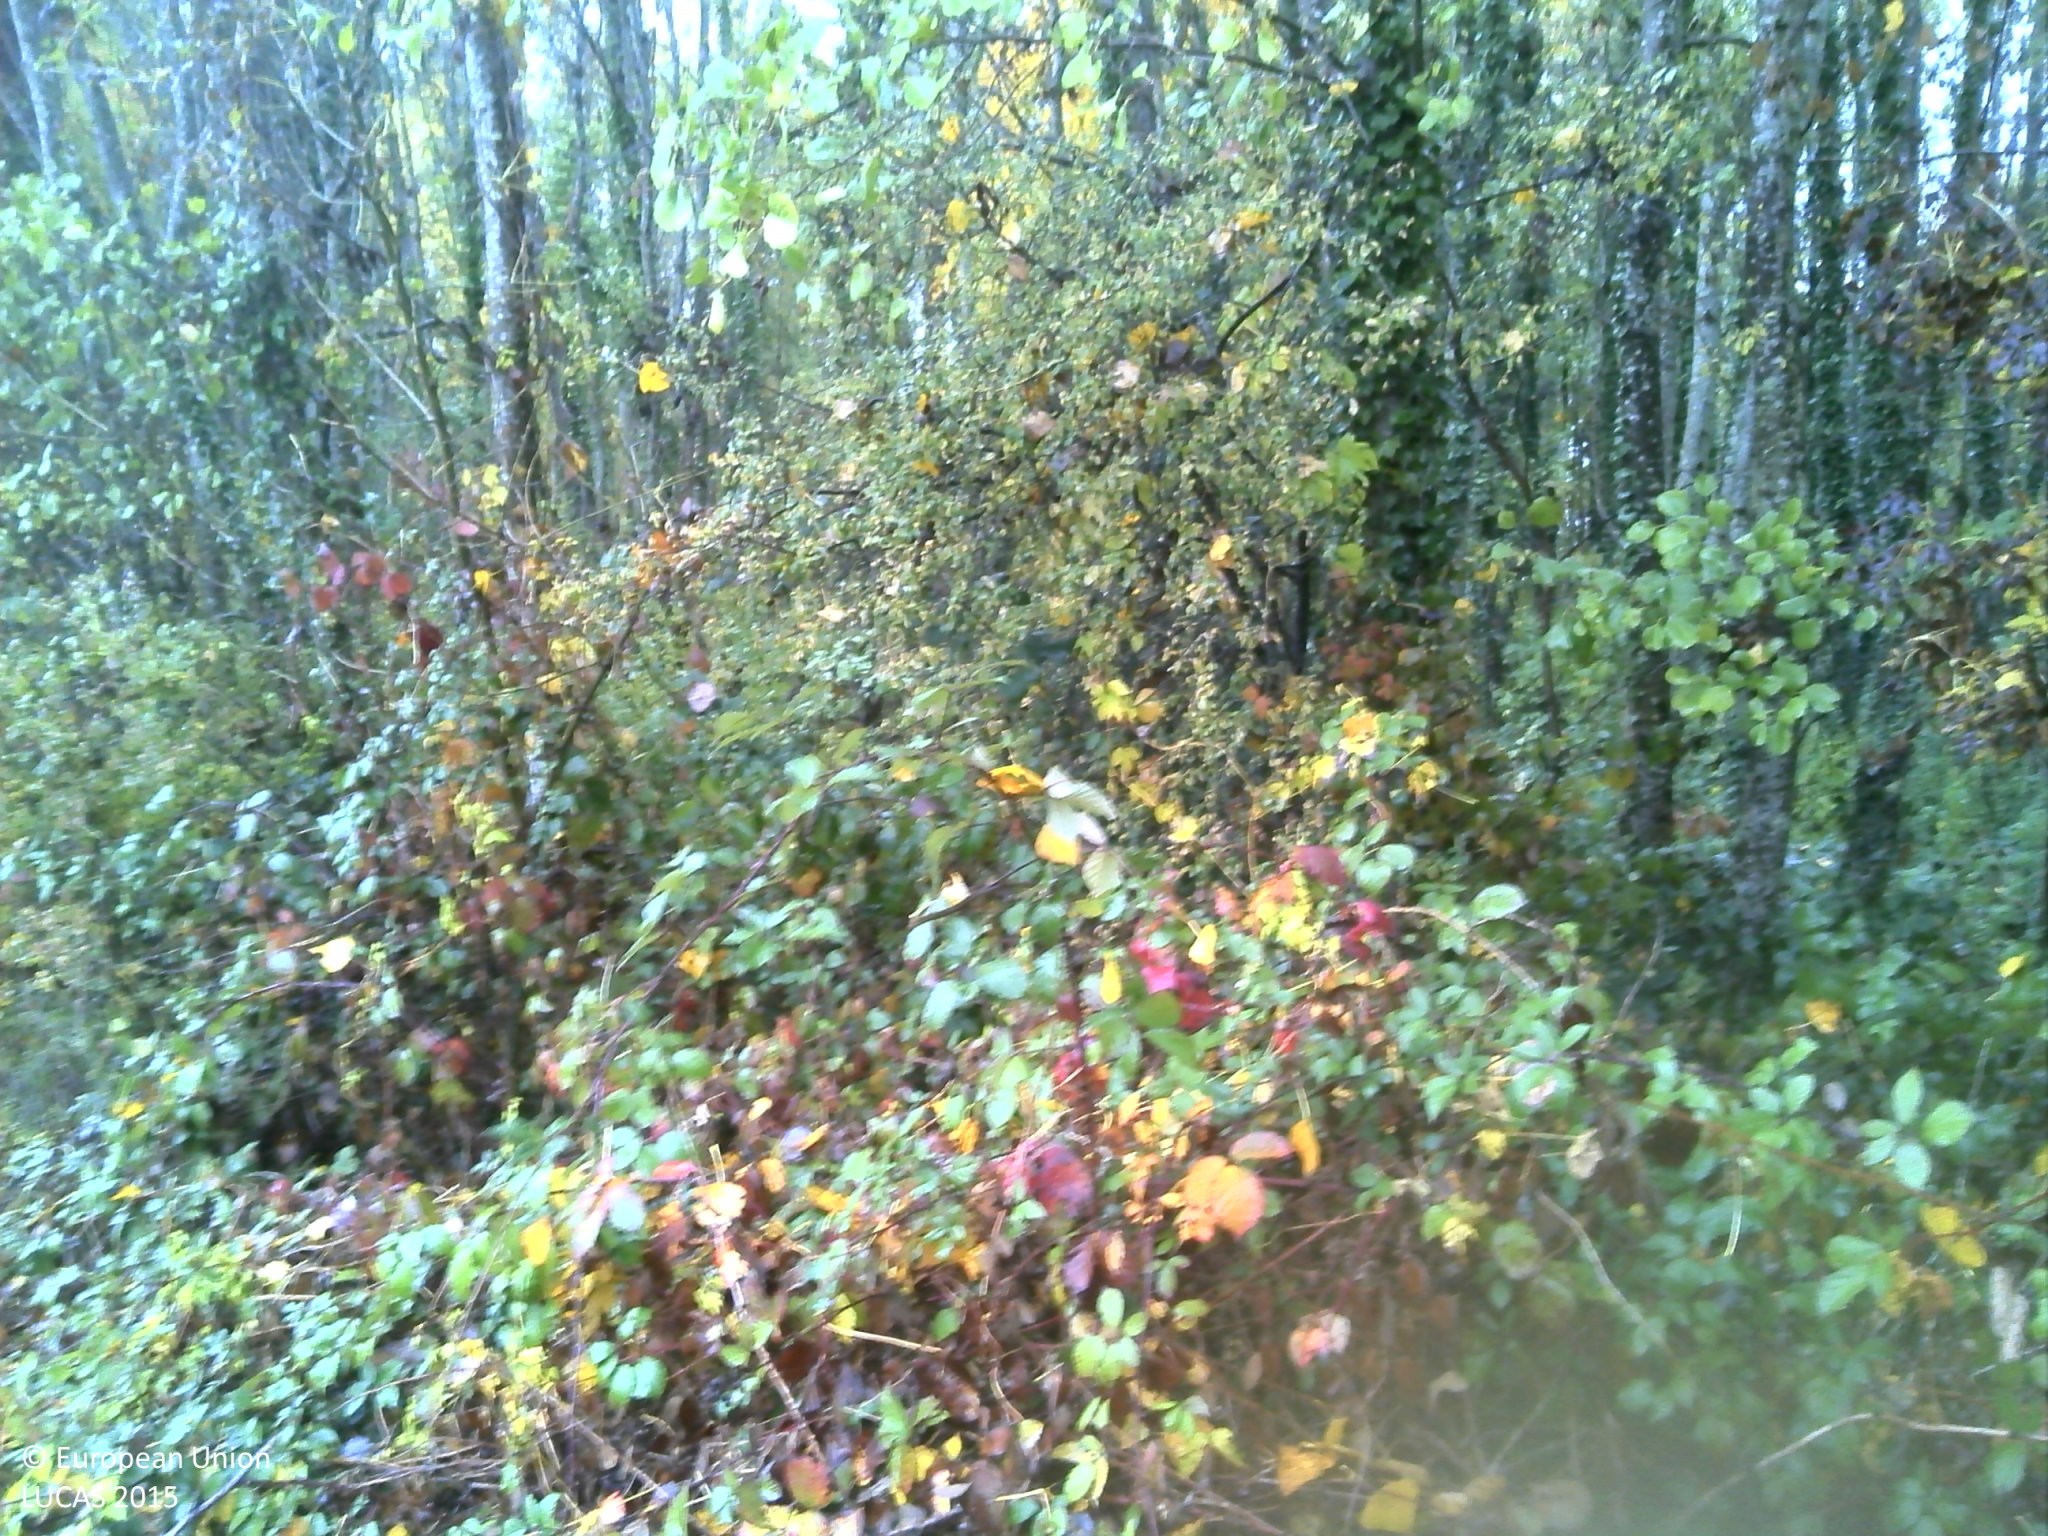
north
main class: Woodland
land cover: Broadleaved woodland
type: non-riverine alder, birch or aspen forest
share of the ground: > 75 %
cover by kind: broadleaved forest trees 100 %
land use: Forestry
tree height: > 5 m
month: October
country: FR
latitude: 47.0504
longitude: 5.0911
